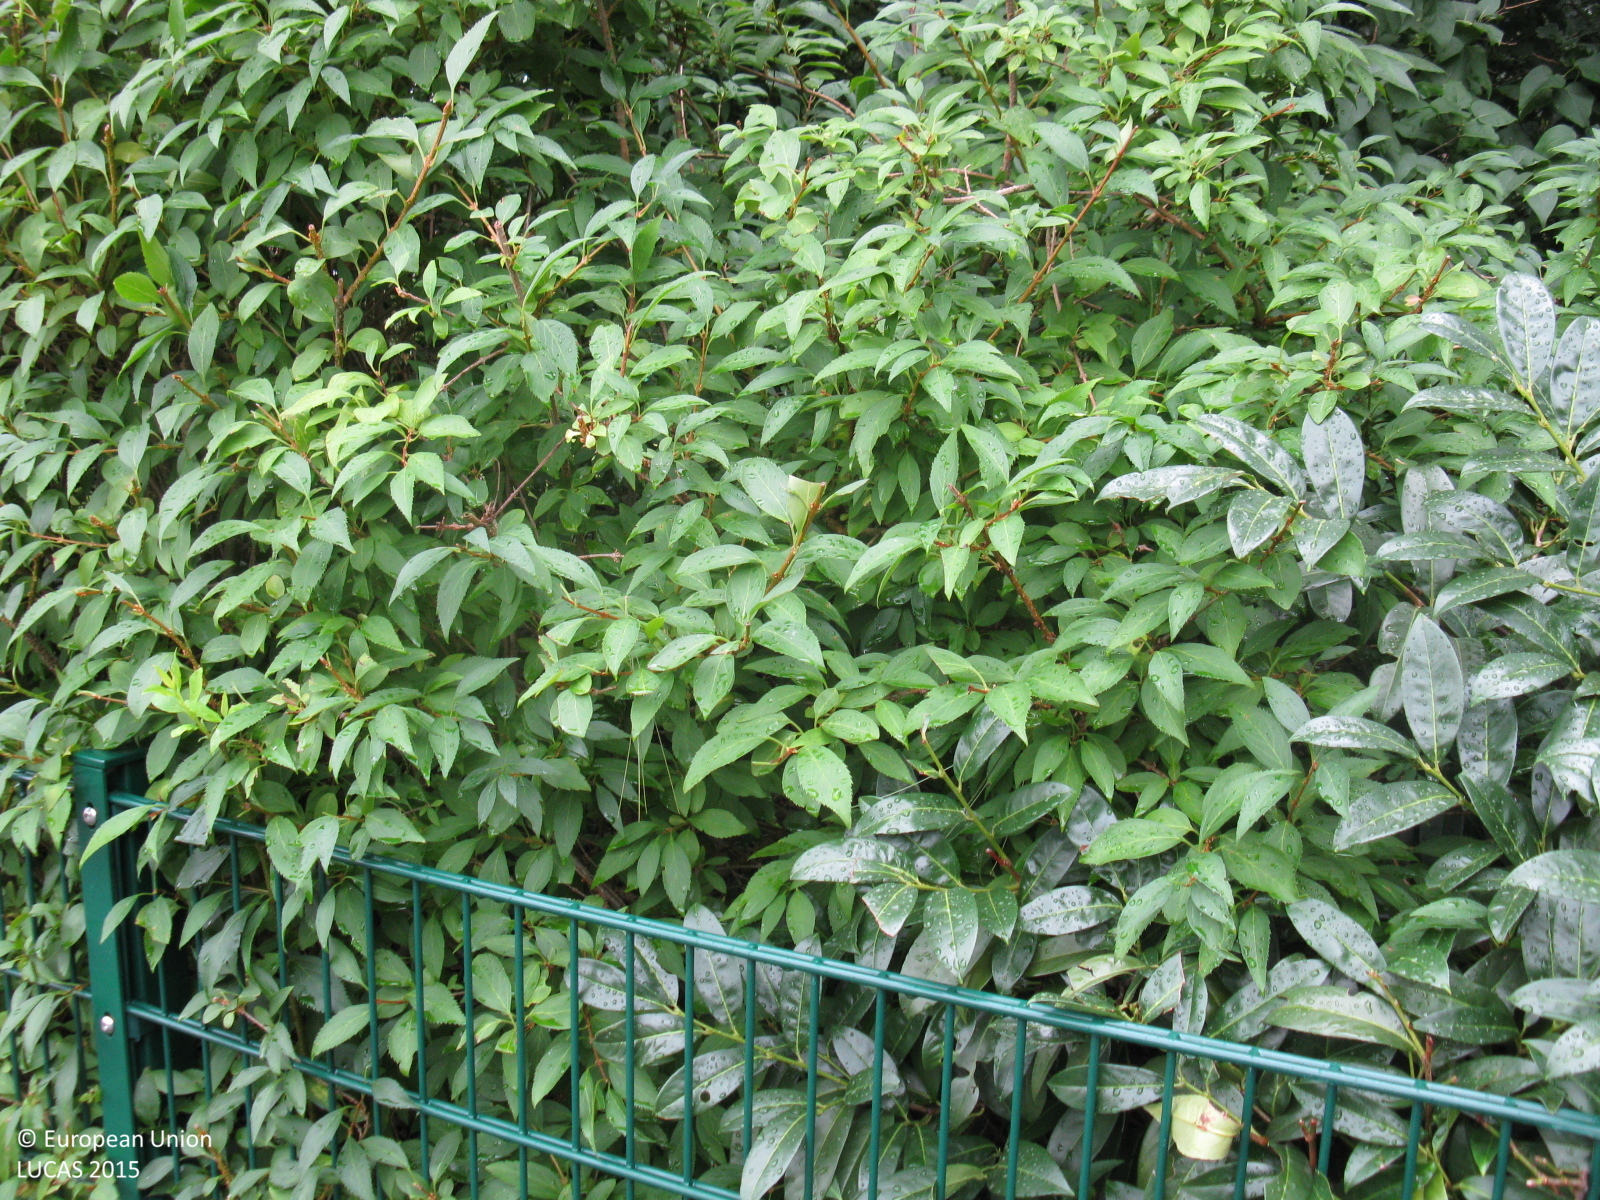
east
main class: Woodland
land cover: Broadleaved woodland
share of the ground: 50 - 75 %
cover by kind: broadleaved forest trees 70 %, herbaceous plants 30 %
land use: Residential
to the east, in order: Broadleaved woodland; Artificial constructions in urban areas
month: August
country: DE
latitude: 51.6548
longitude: 6.9501
